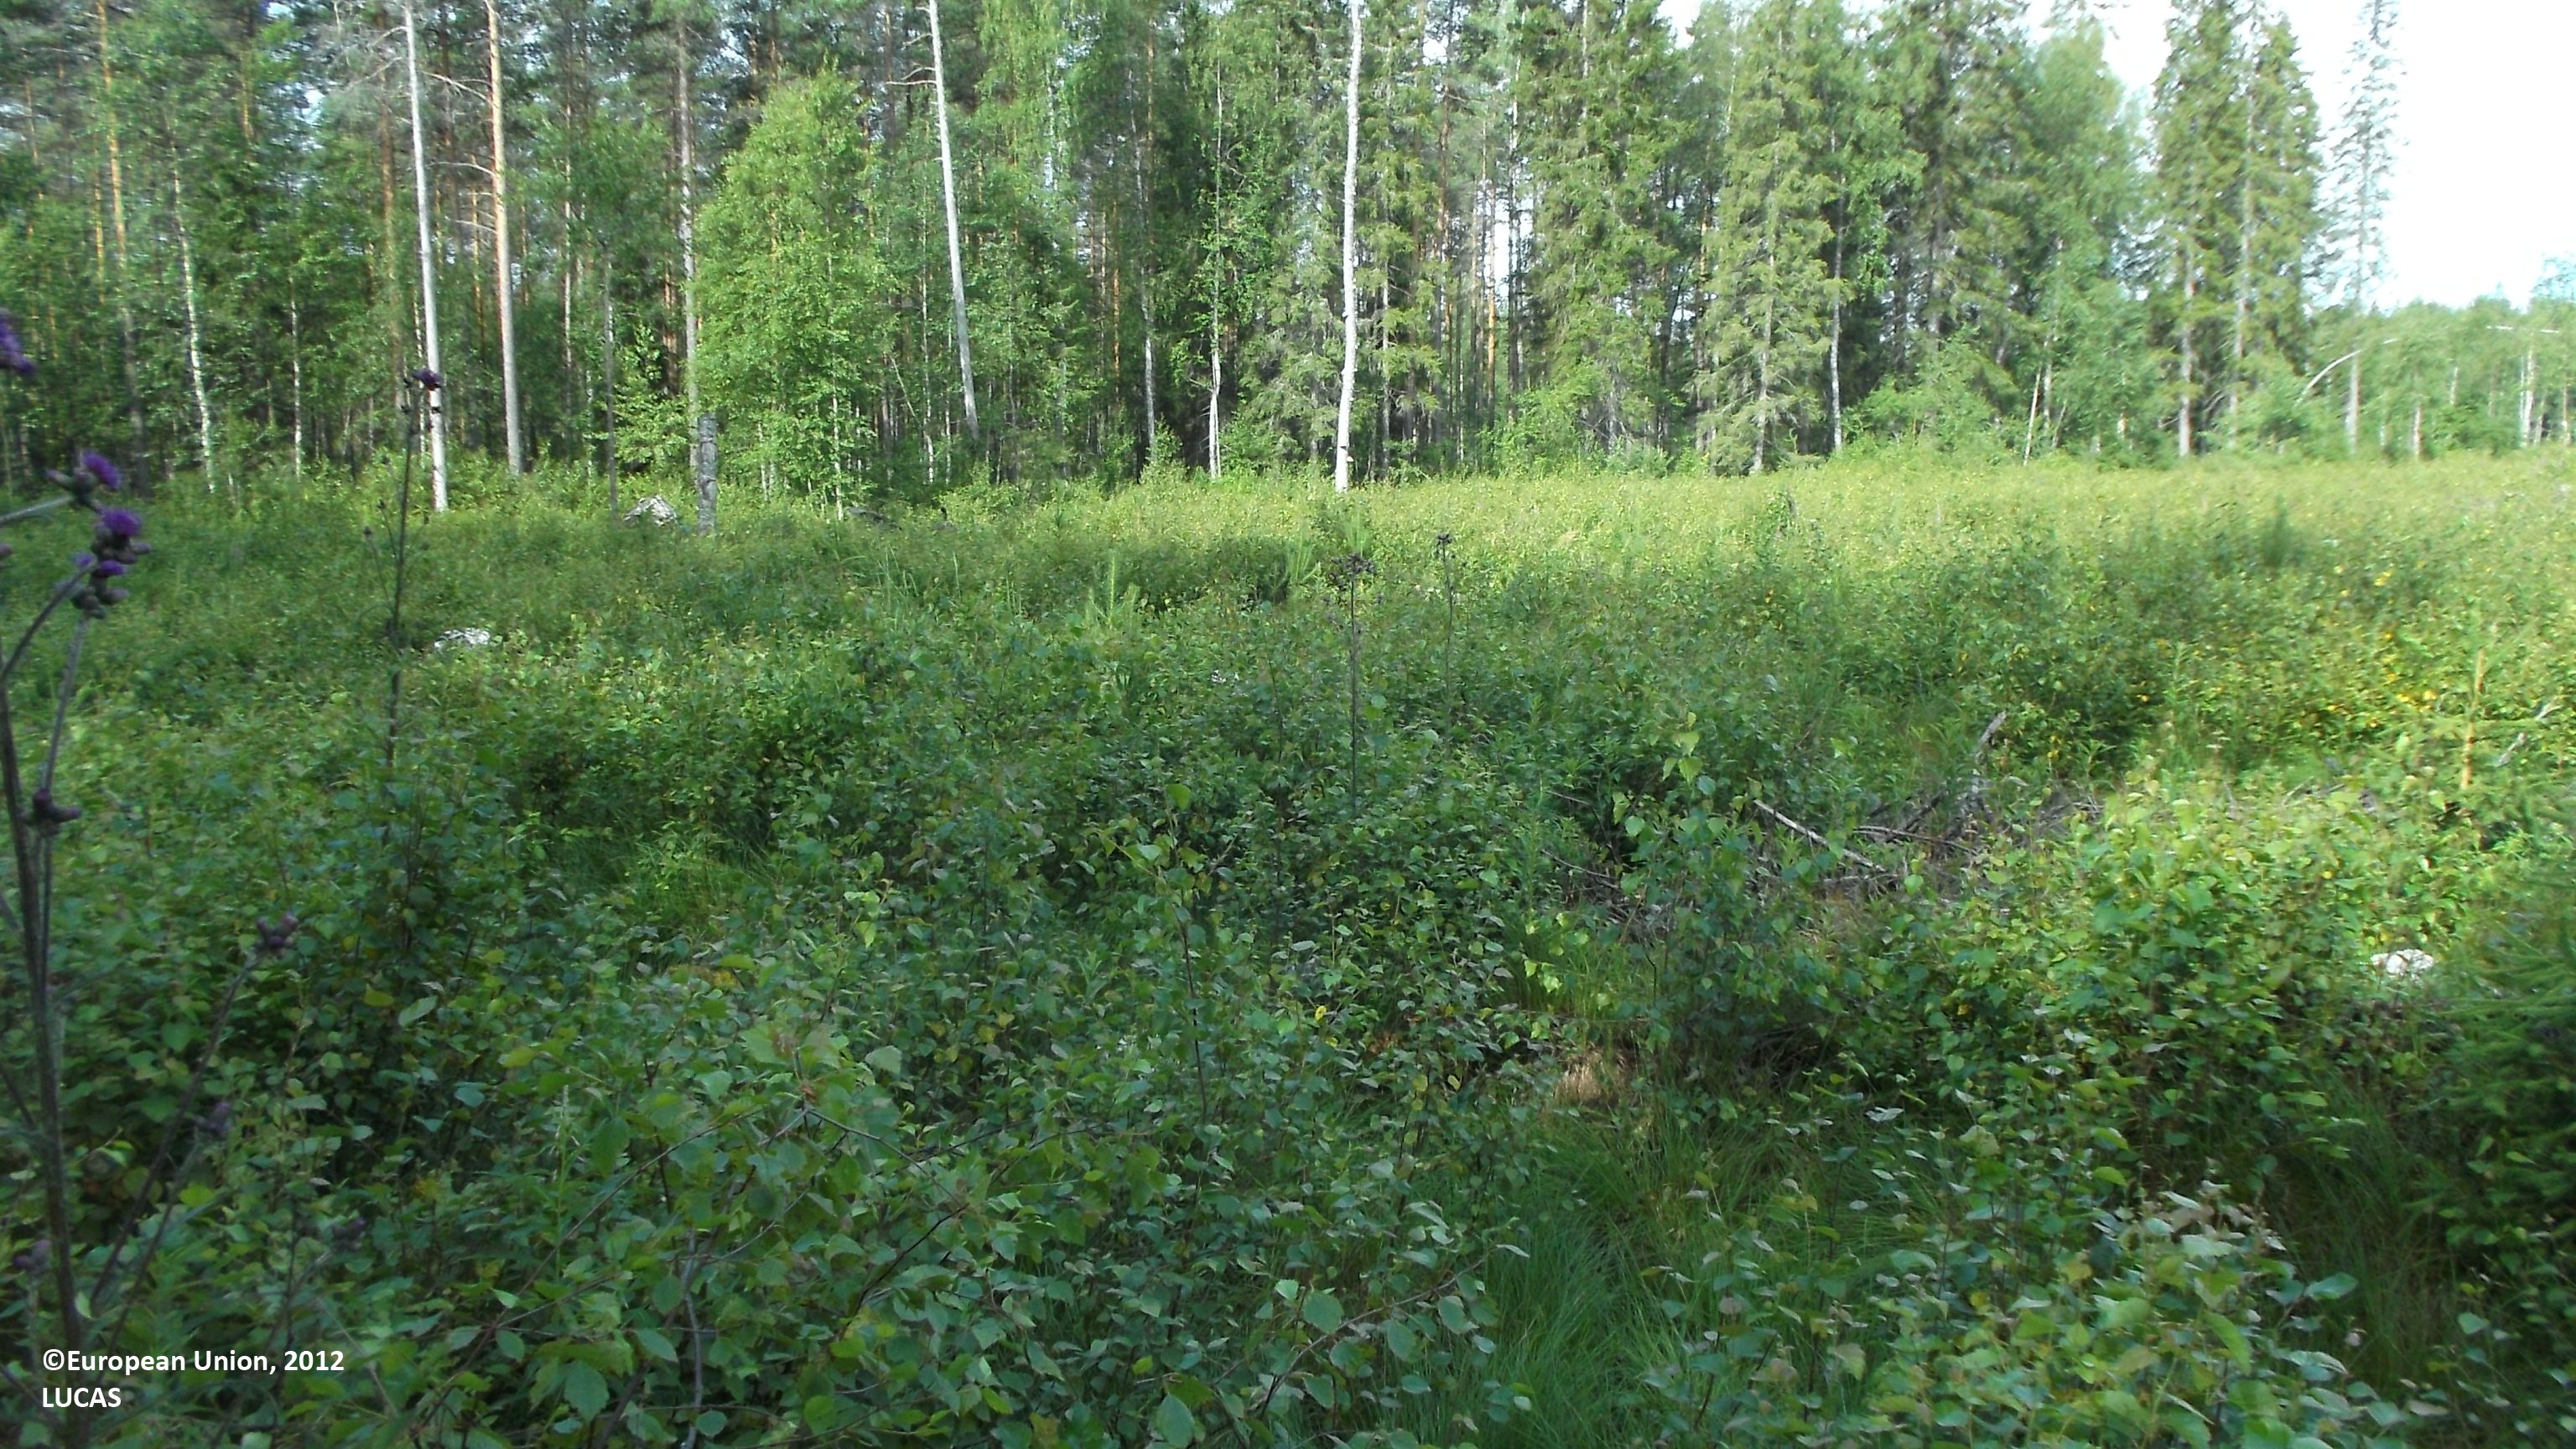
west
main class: Woodland
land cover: Broadleaved woodland
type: boreal forest
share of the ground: > 75 %
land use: Forestry
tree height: < 5 m
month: July
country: FI
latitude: 63.5056
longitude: 23.9121
